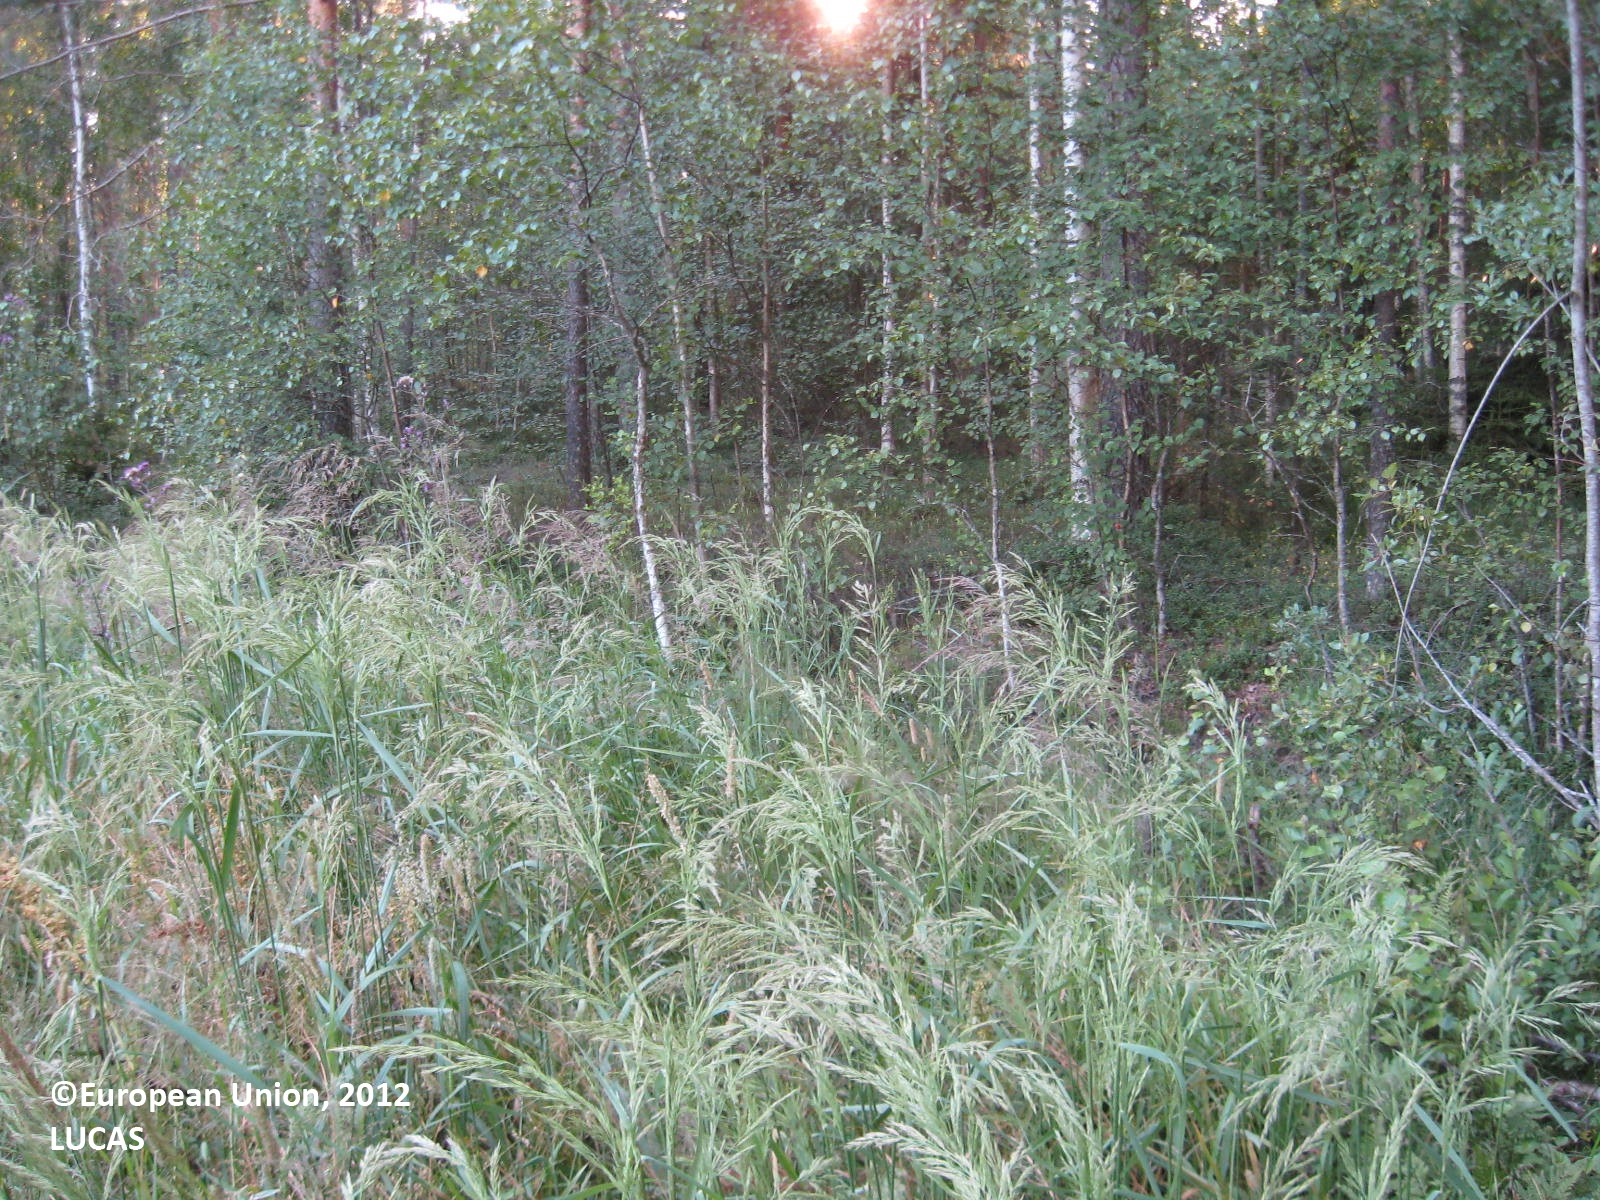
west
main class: Grassland
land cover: Spontaneously vegetated surfaces
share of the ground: > 75 %
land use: Abandoned areas
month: July
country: FI
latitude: 61.8613
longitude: 22.1639
